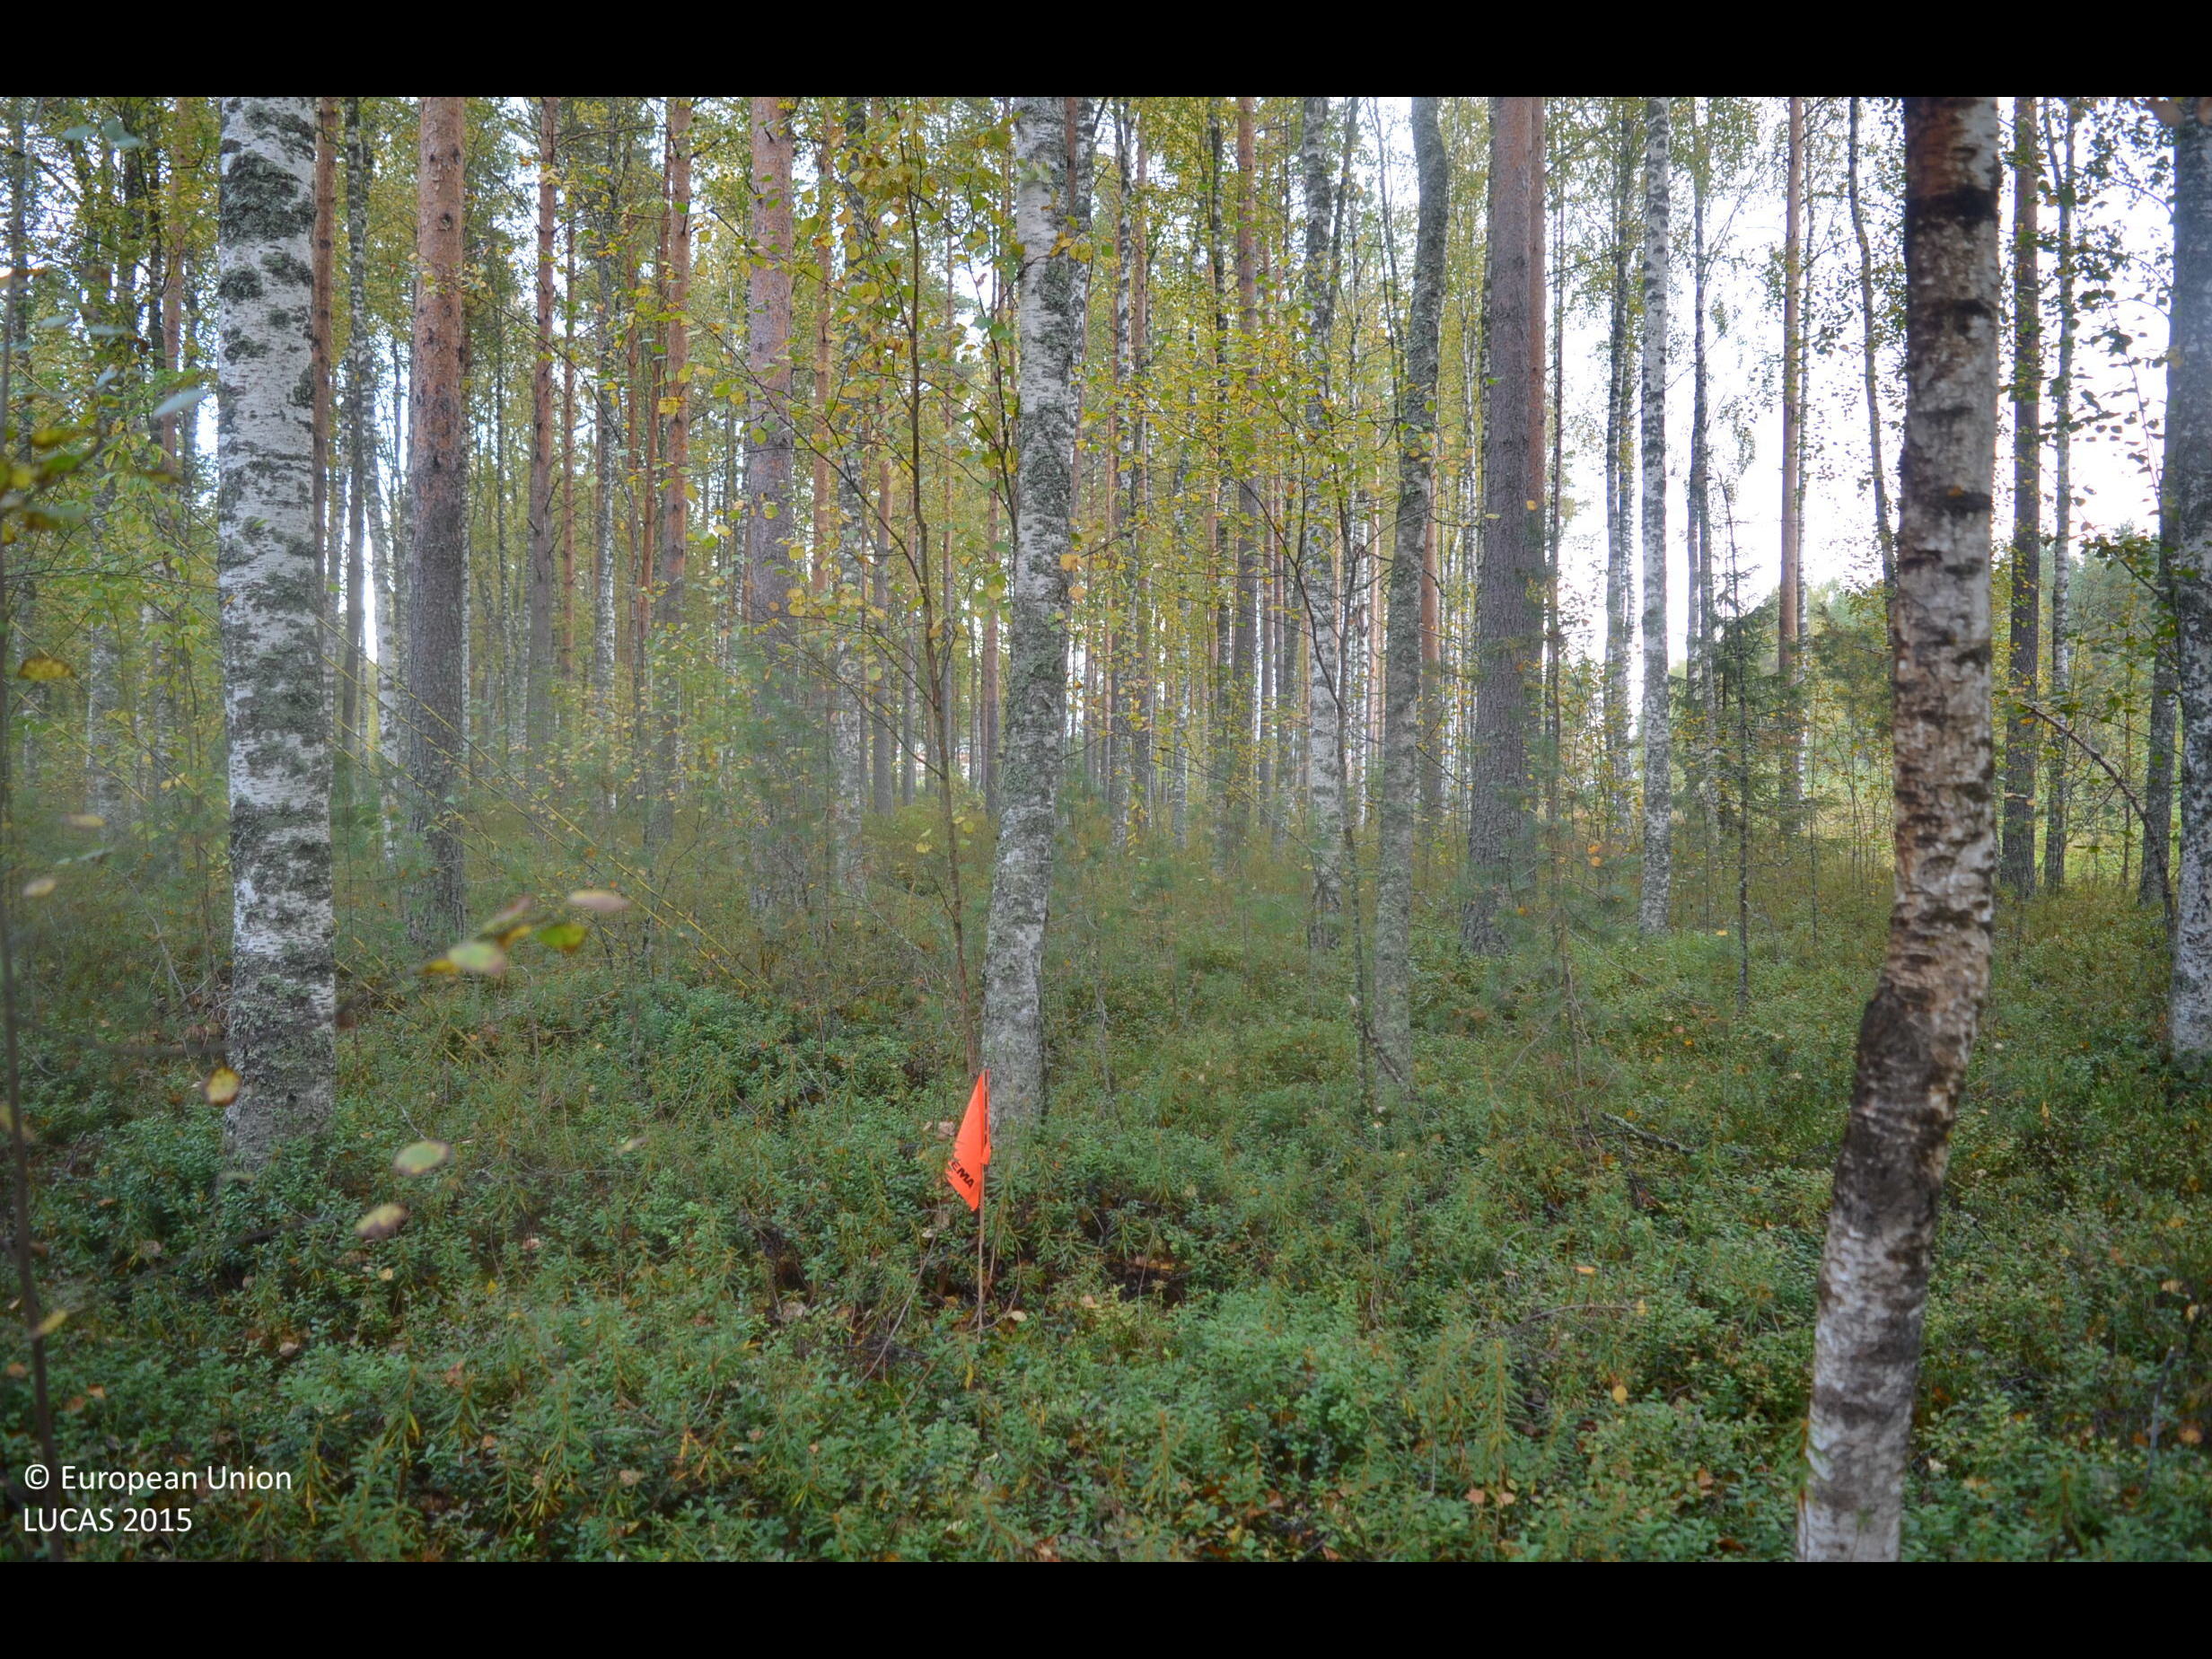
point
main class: Woodland
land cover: Pine dominated mixed woodland
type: boreal forest
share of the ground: > 75 %
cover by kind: broadleaved forest trees 40 %, coniferous forest trees 35 %, shrubs 25 %
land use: Forestry
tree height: > 5 m
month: September
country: FI
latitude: 63.0017
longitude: 23.7943
